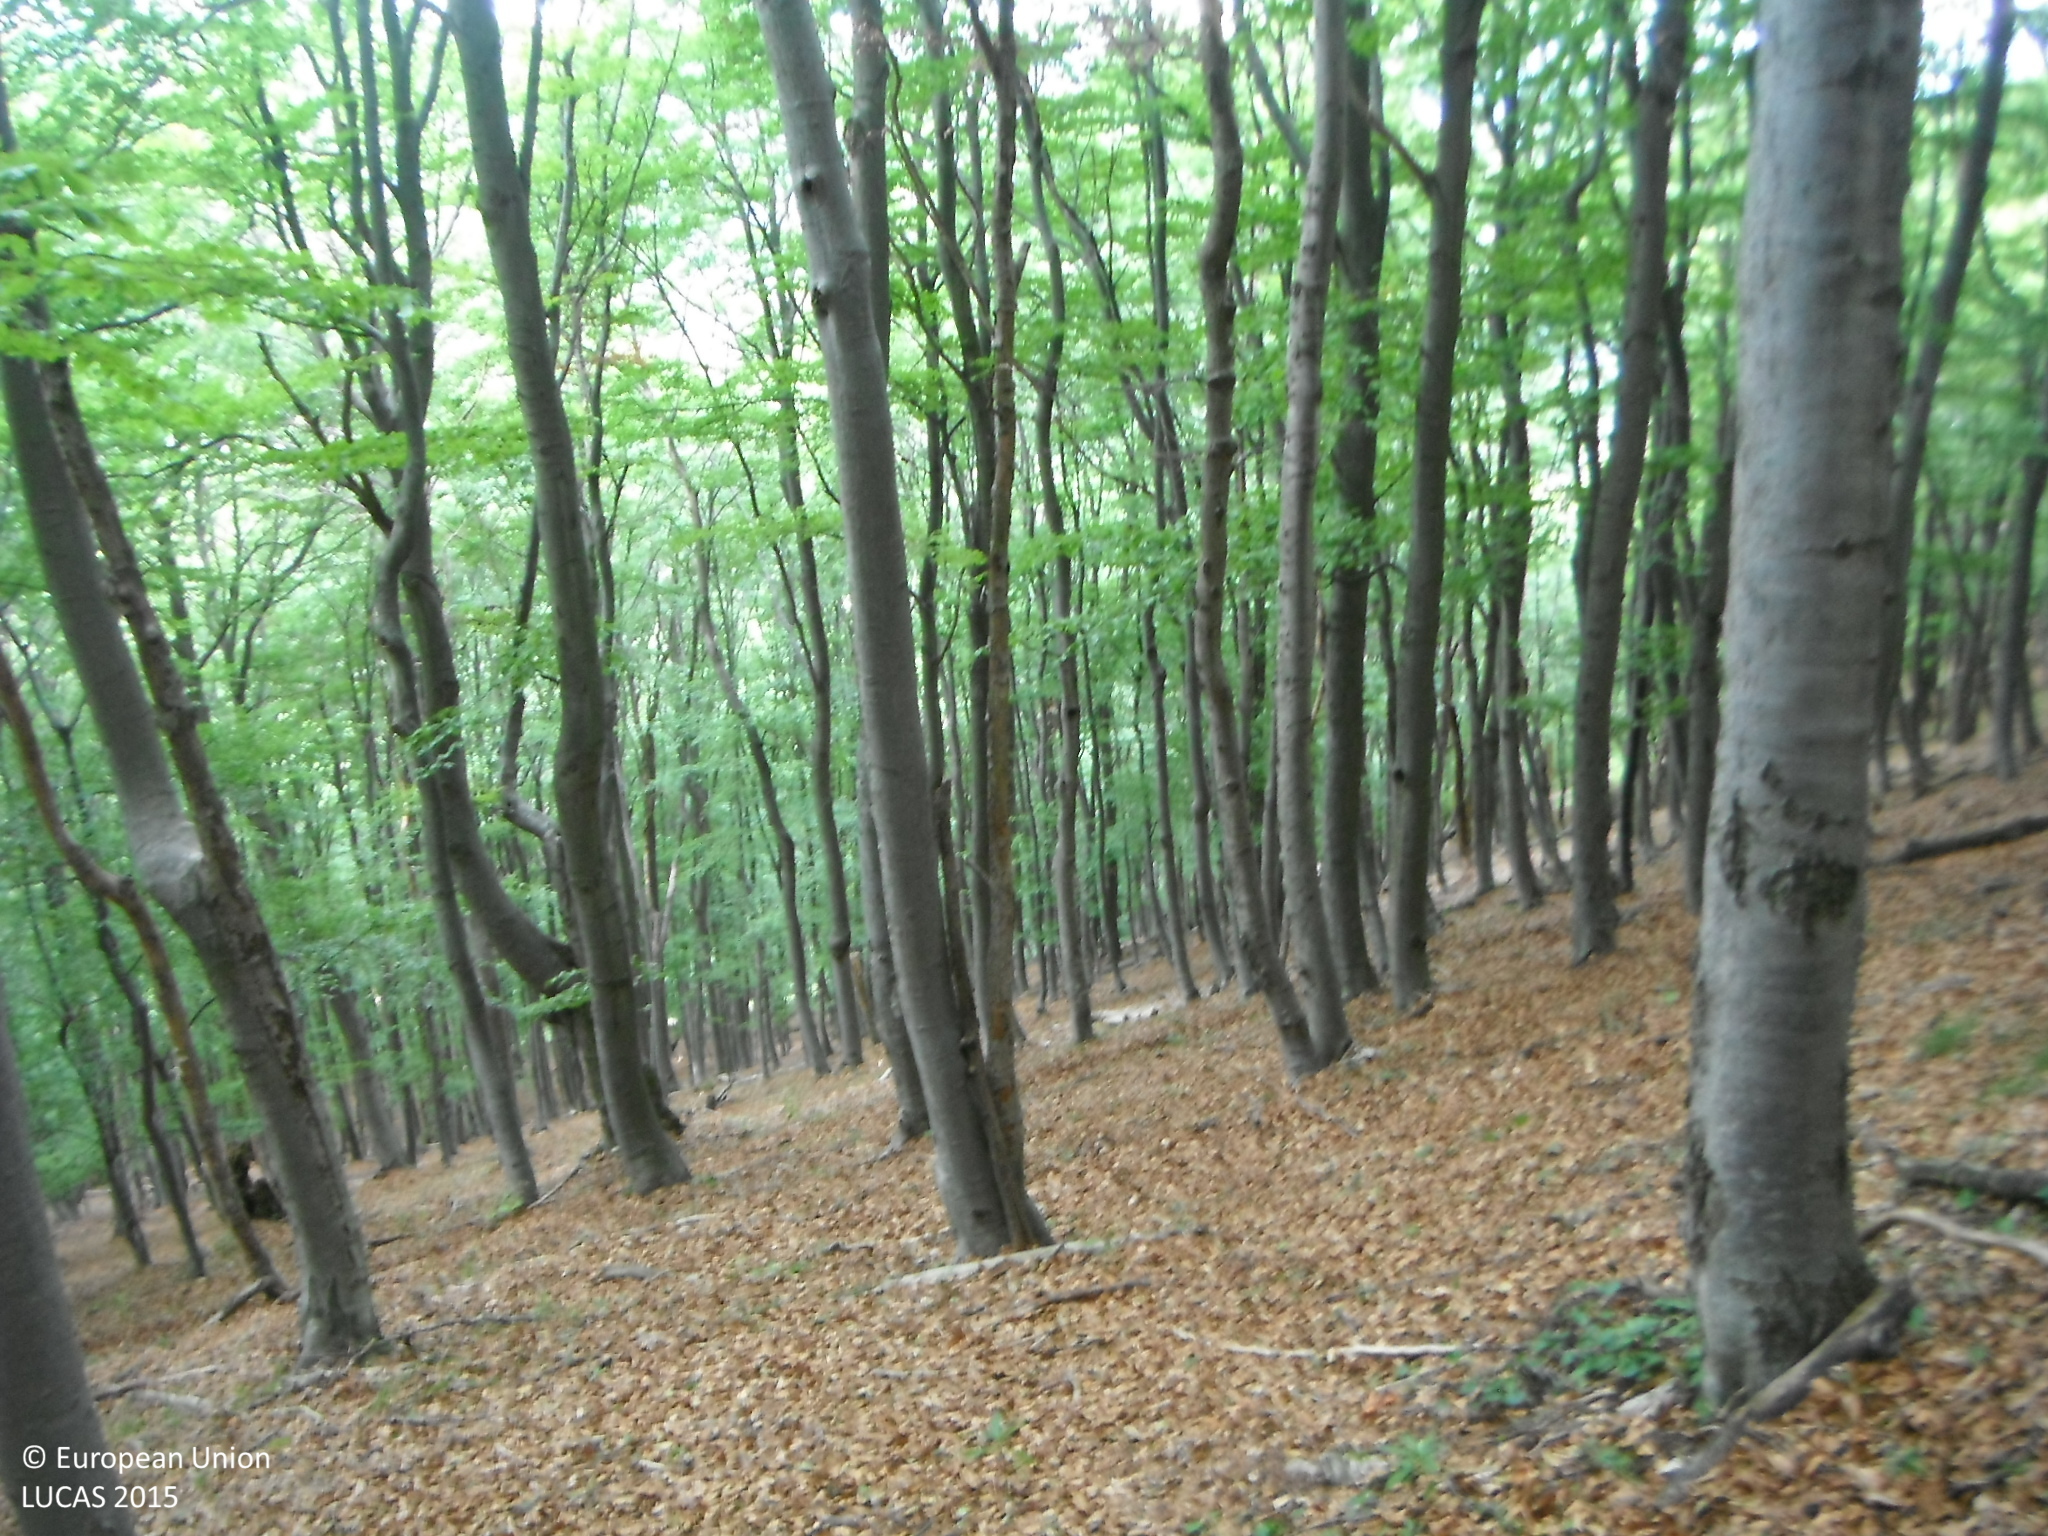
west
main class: Woodland
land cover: Broadleaved woodland
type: mountainous beech forest
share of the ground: > 75 %
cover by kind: broadleaved forest trees 85 %, herbaceous plants 5 %, consolidated bare surface 5 %
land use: Forestry
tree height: > 5 m
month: September
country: SK
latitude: 48.9189
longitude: 18.3547
